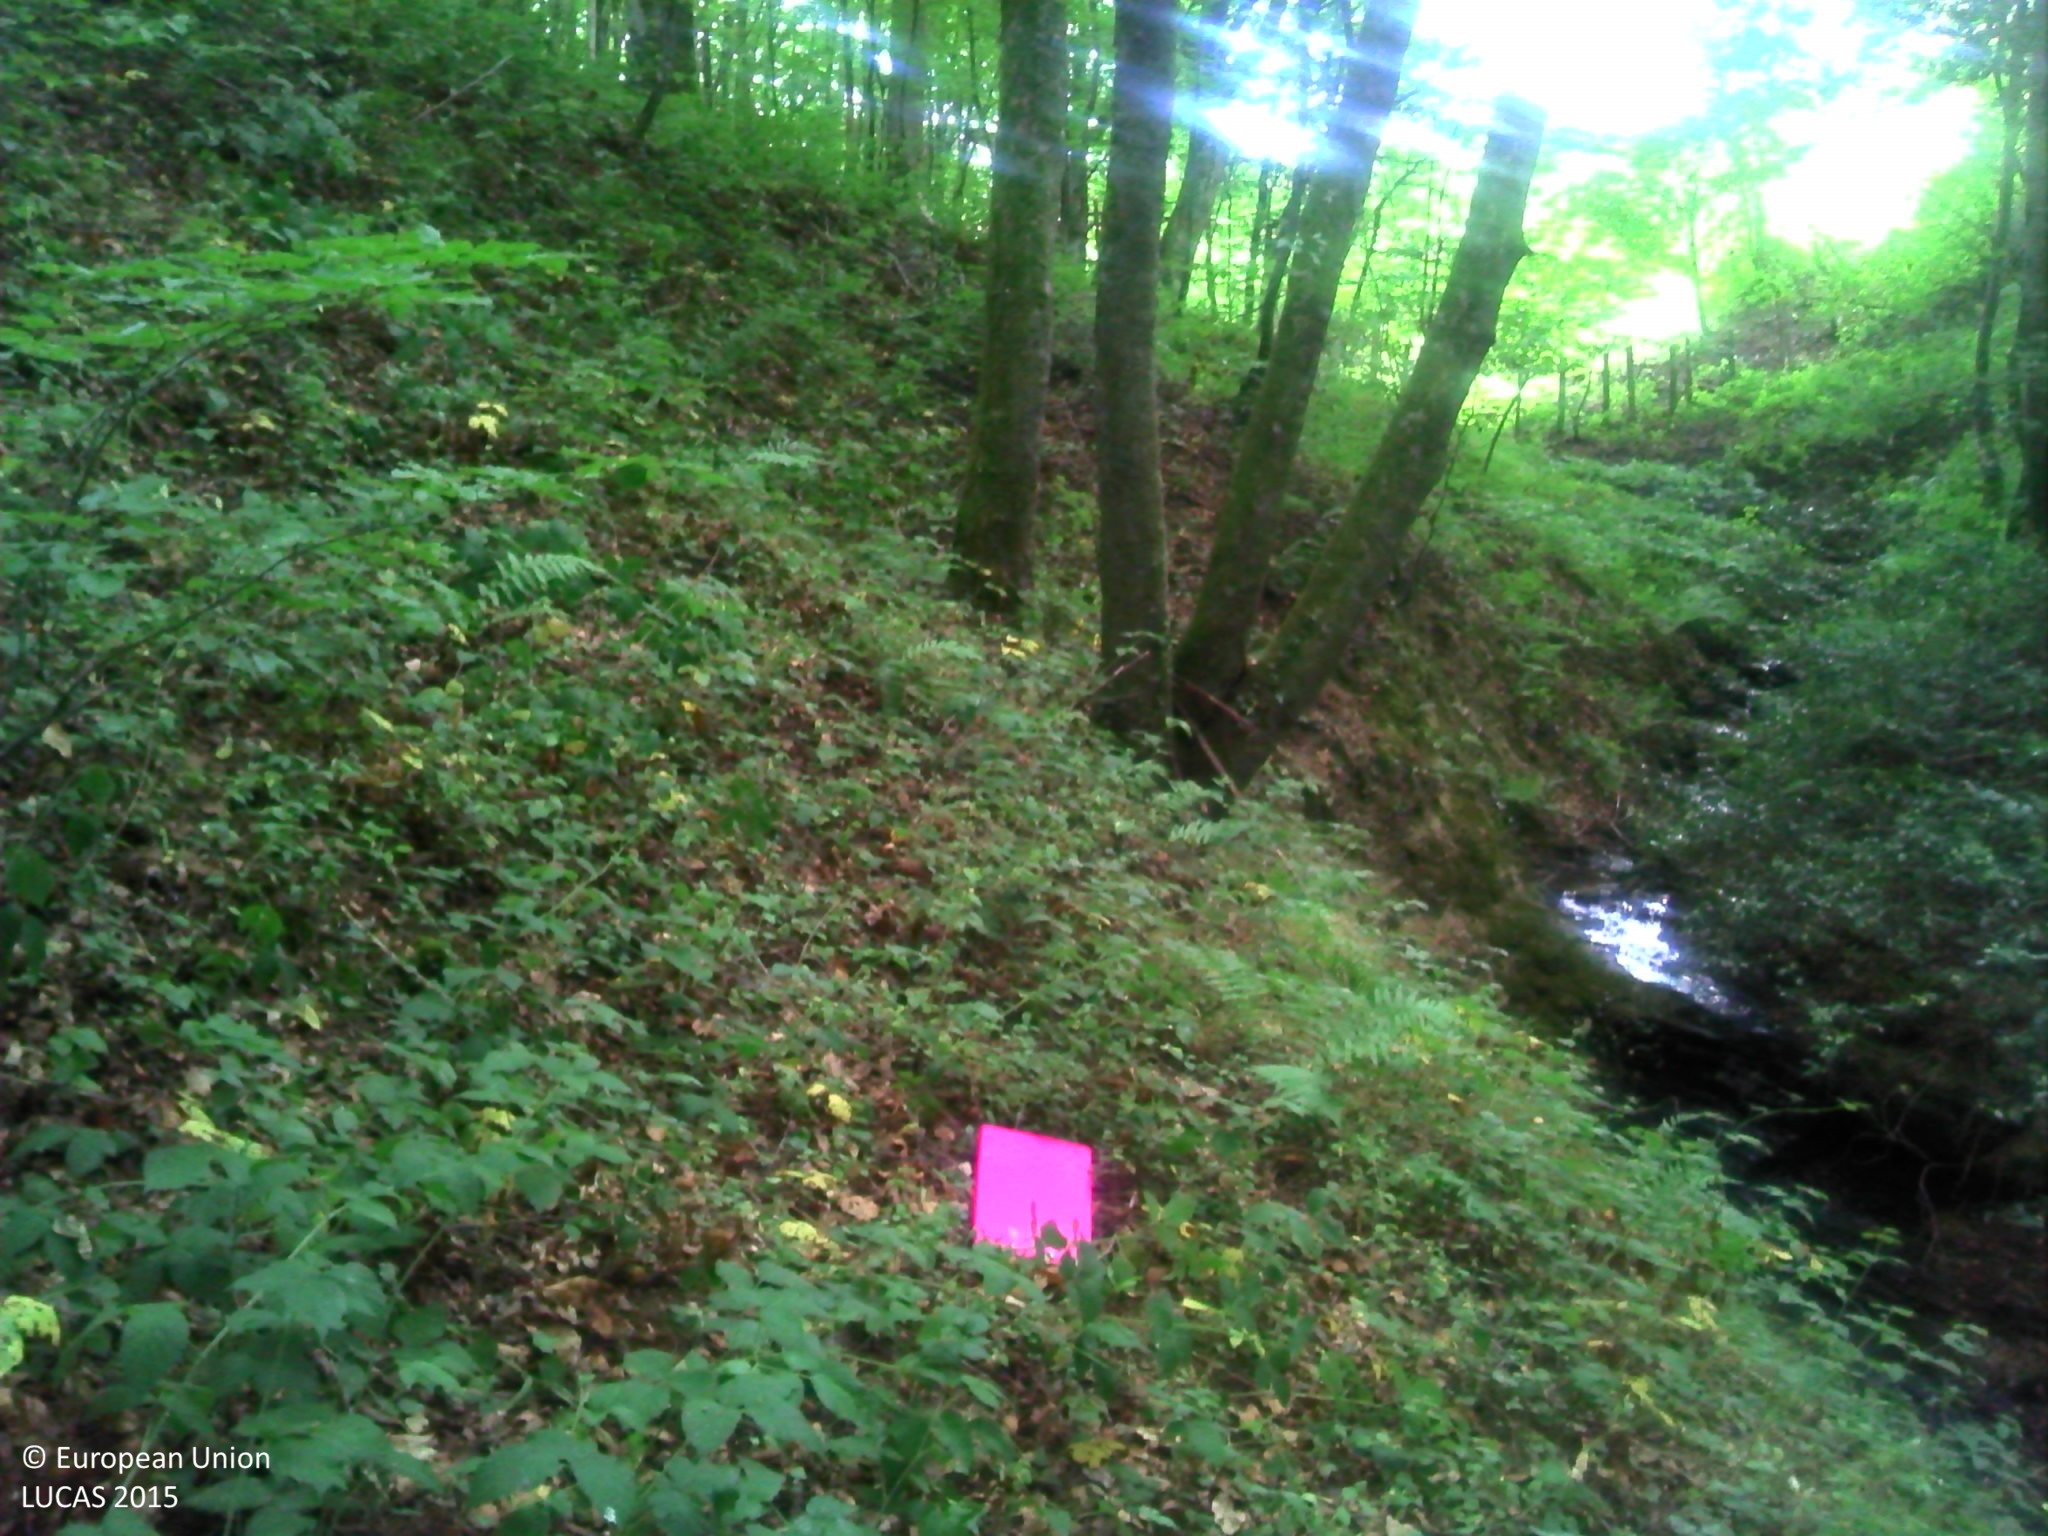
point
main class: Woodland
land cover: Broadleaved woodland
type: mesophytic deciduous forest
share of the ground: > 75 %
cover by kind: broadleaved forest trees 85 %, herbaceous plants 10 %, shrubs 5 %
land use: Forestry
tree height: > 5 m
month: July
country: FR
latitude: 46.3730
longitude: 1.7104
